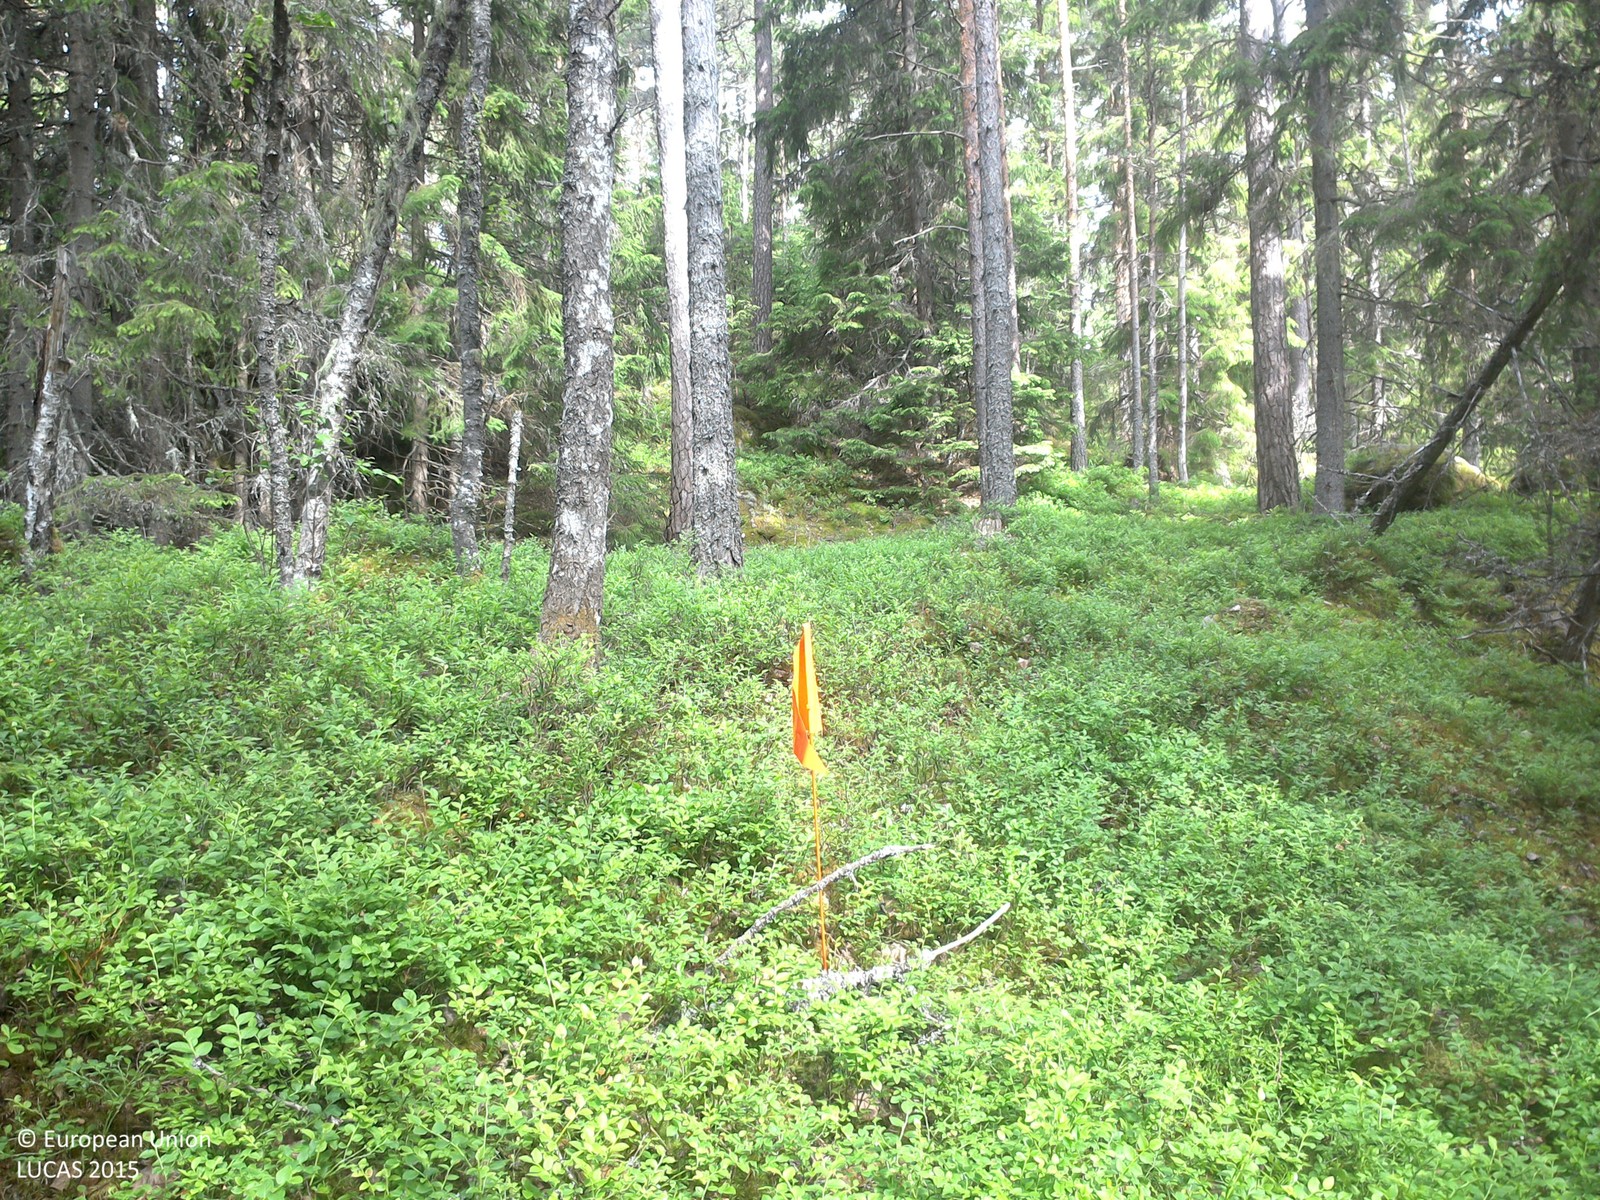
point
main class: Woodland
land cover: Spruce dominated coniferous woodland
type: boreal forest
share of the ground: 50 - 75 %
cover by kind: coniferous forest trees 60 %, lichens and mosses 20 %, herbaceous plants 15 %, broadleaved forest trees 5 %
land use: Forestry
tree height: > 5 m
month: June
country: SE
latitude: 58.1424
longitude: 15.5159
